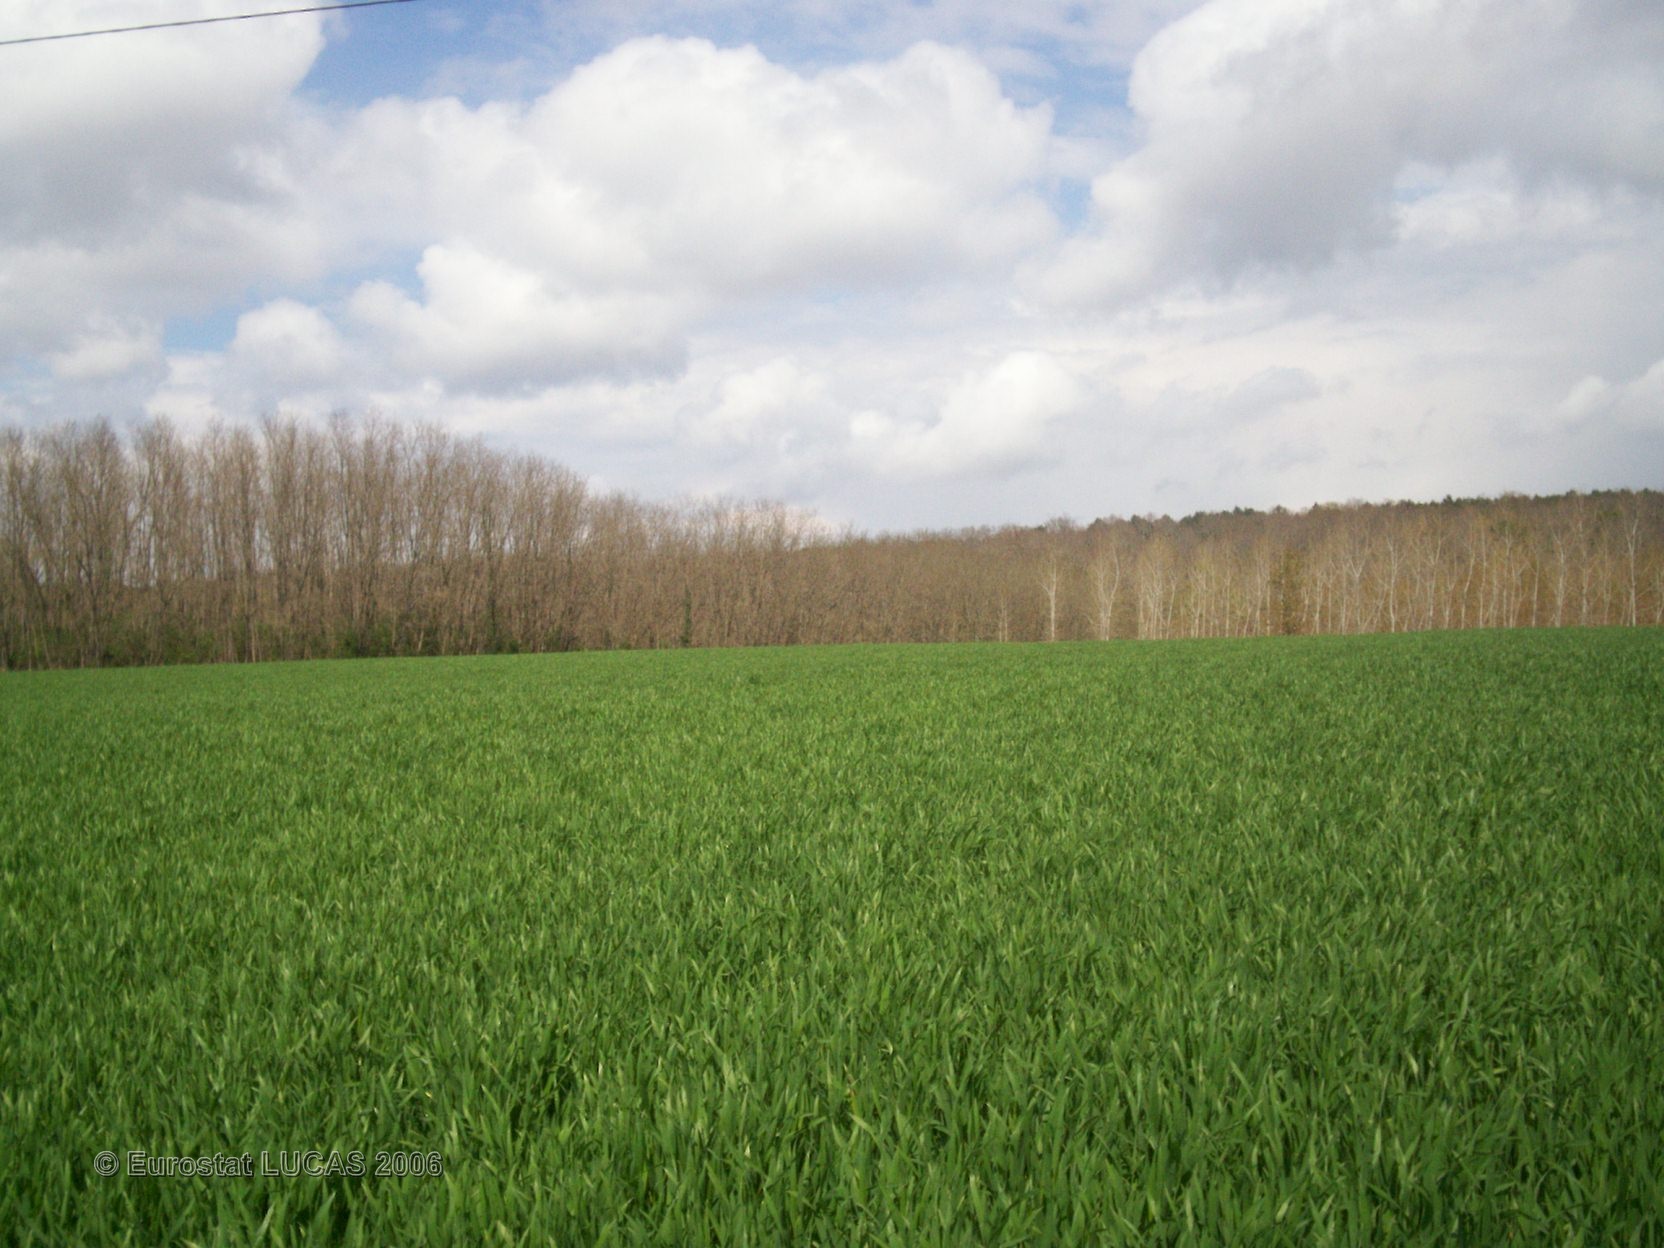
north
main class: Cropland
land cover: Common wheat
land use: Agriculture (excluding fallow land and kitchen gardens)
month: April
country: FR
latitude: 44.0510
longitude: 0.2197
